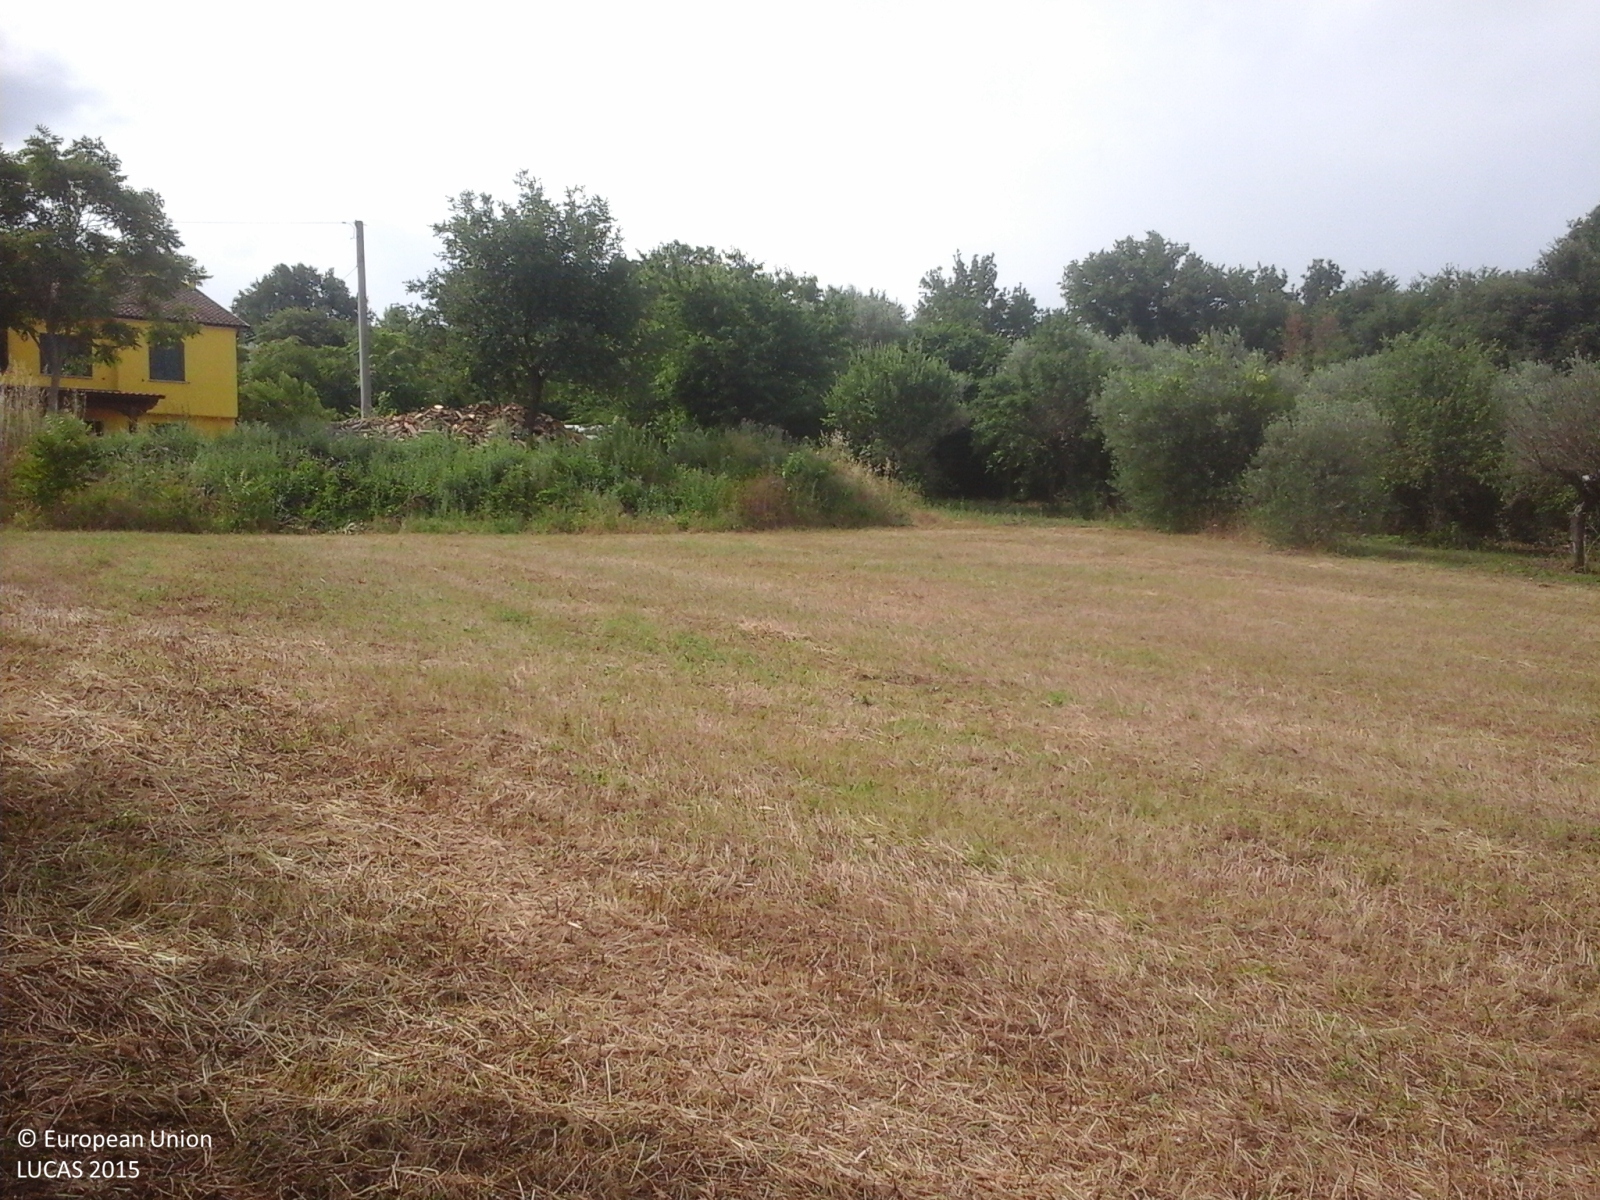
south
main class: Woodland
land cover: Broadleaved woodland
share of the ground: > 75 %
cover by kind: broadleaved forest trees 90 %, shrubs 10 %
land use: Abandoned areas
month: June
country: IT
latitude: 41.0213
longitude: 15.1300
